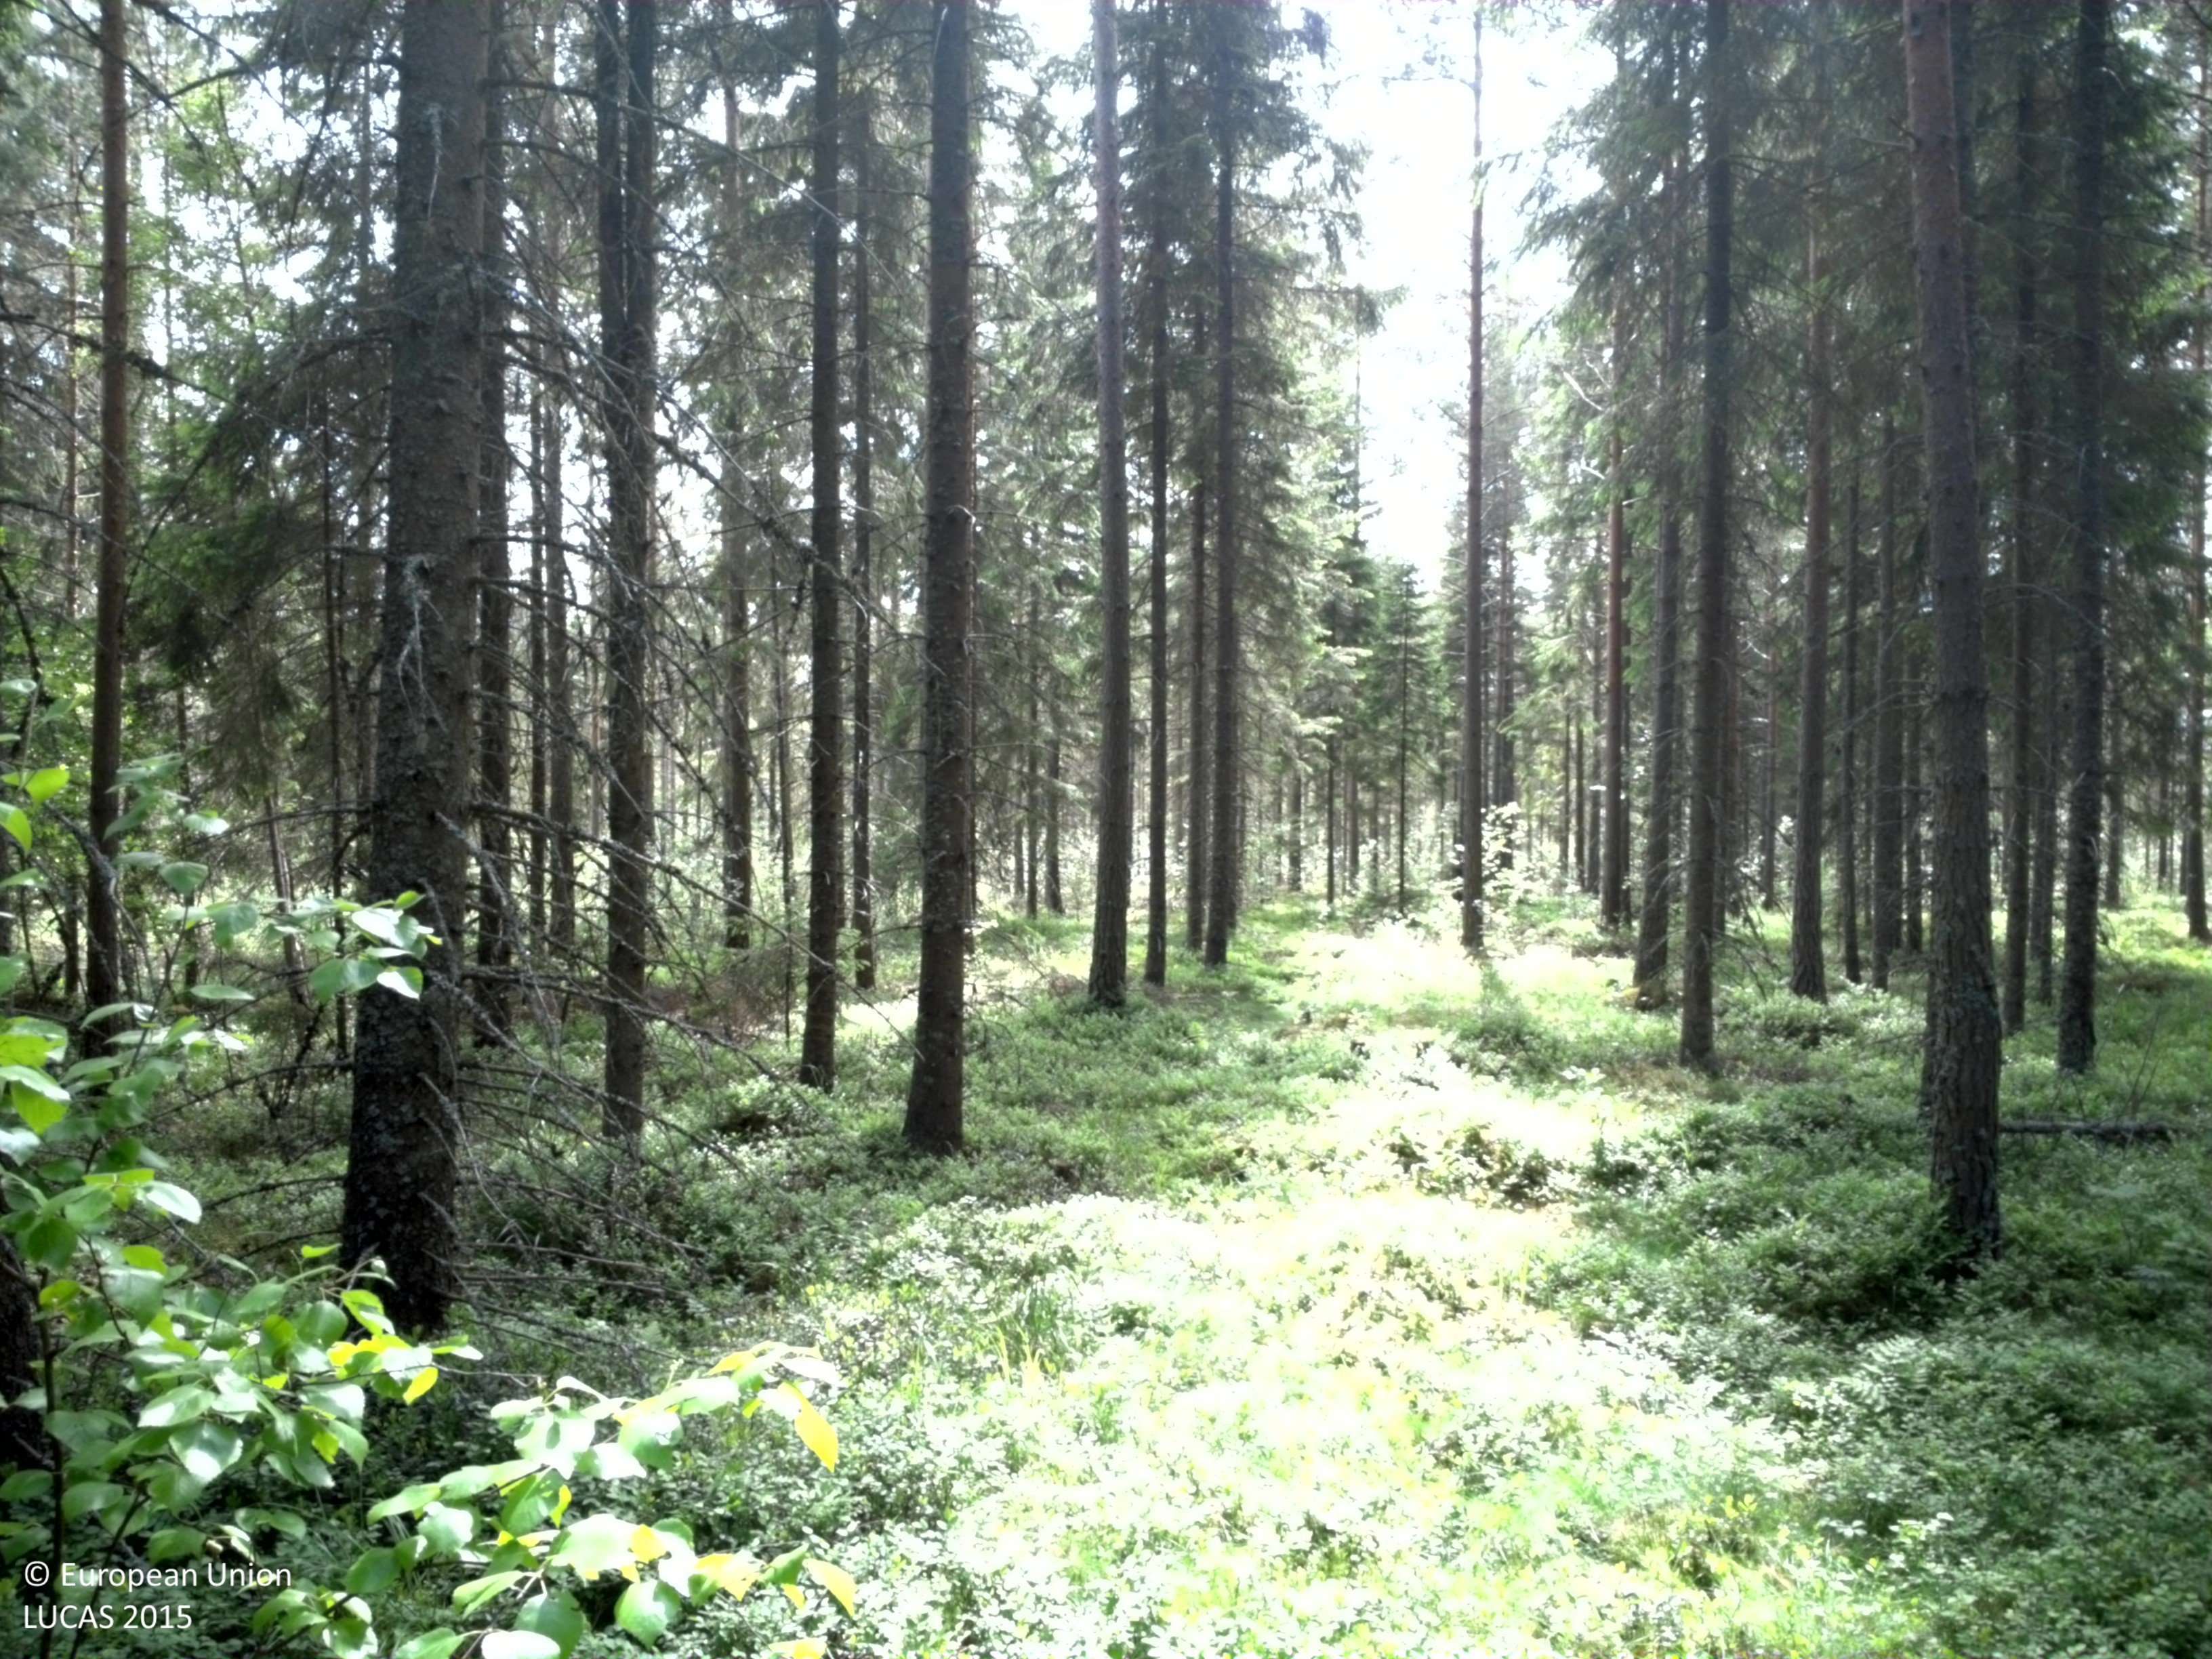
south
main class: Woodland
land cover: Spruce dominated coniferous woodland
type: boreal forest
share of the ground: 25 - 50 %
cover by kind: coniferous forest trees 45 %, lichens and mosses 35 %, herbaceous plants 20 %
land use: Forestry
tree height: > 5 m
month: June
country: SE
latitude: 60.2232
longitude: 17.0129
